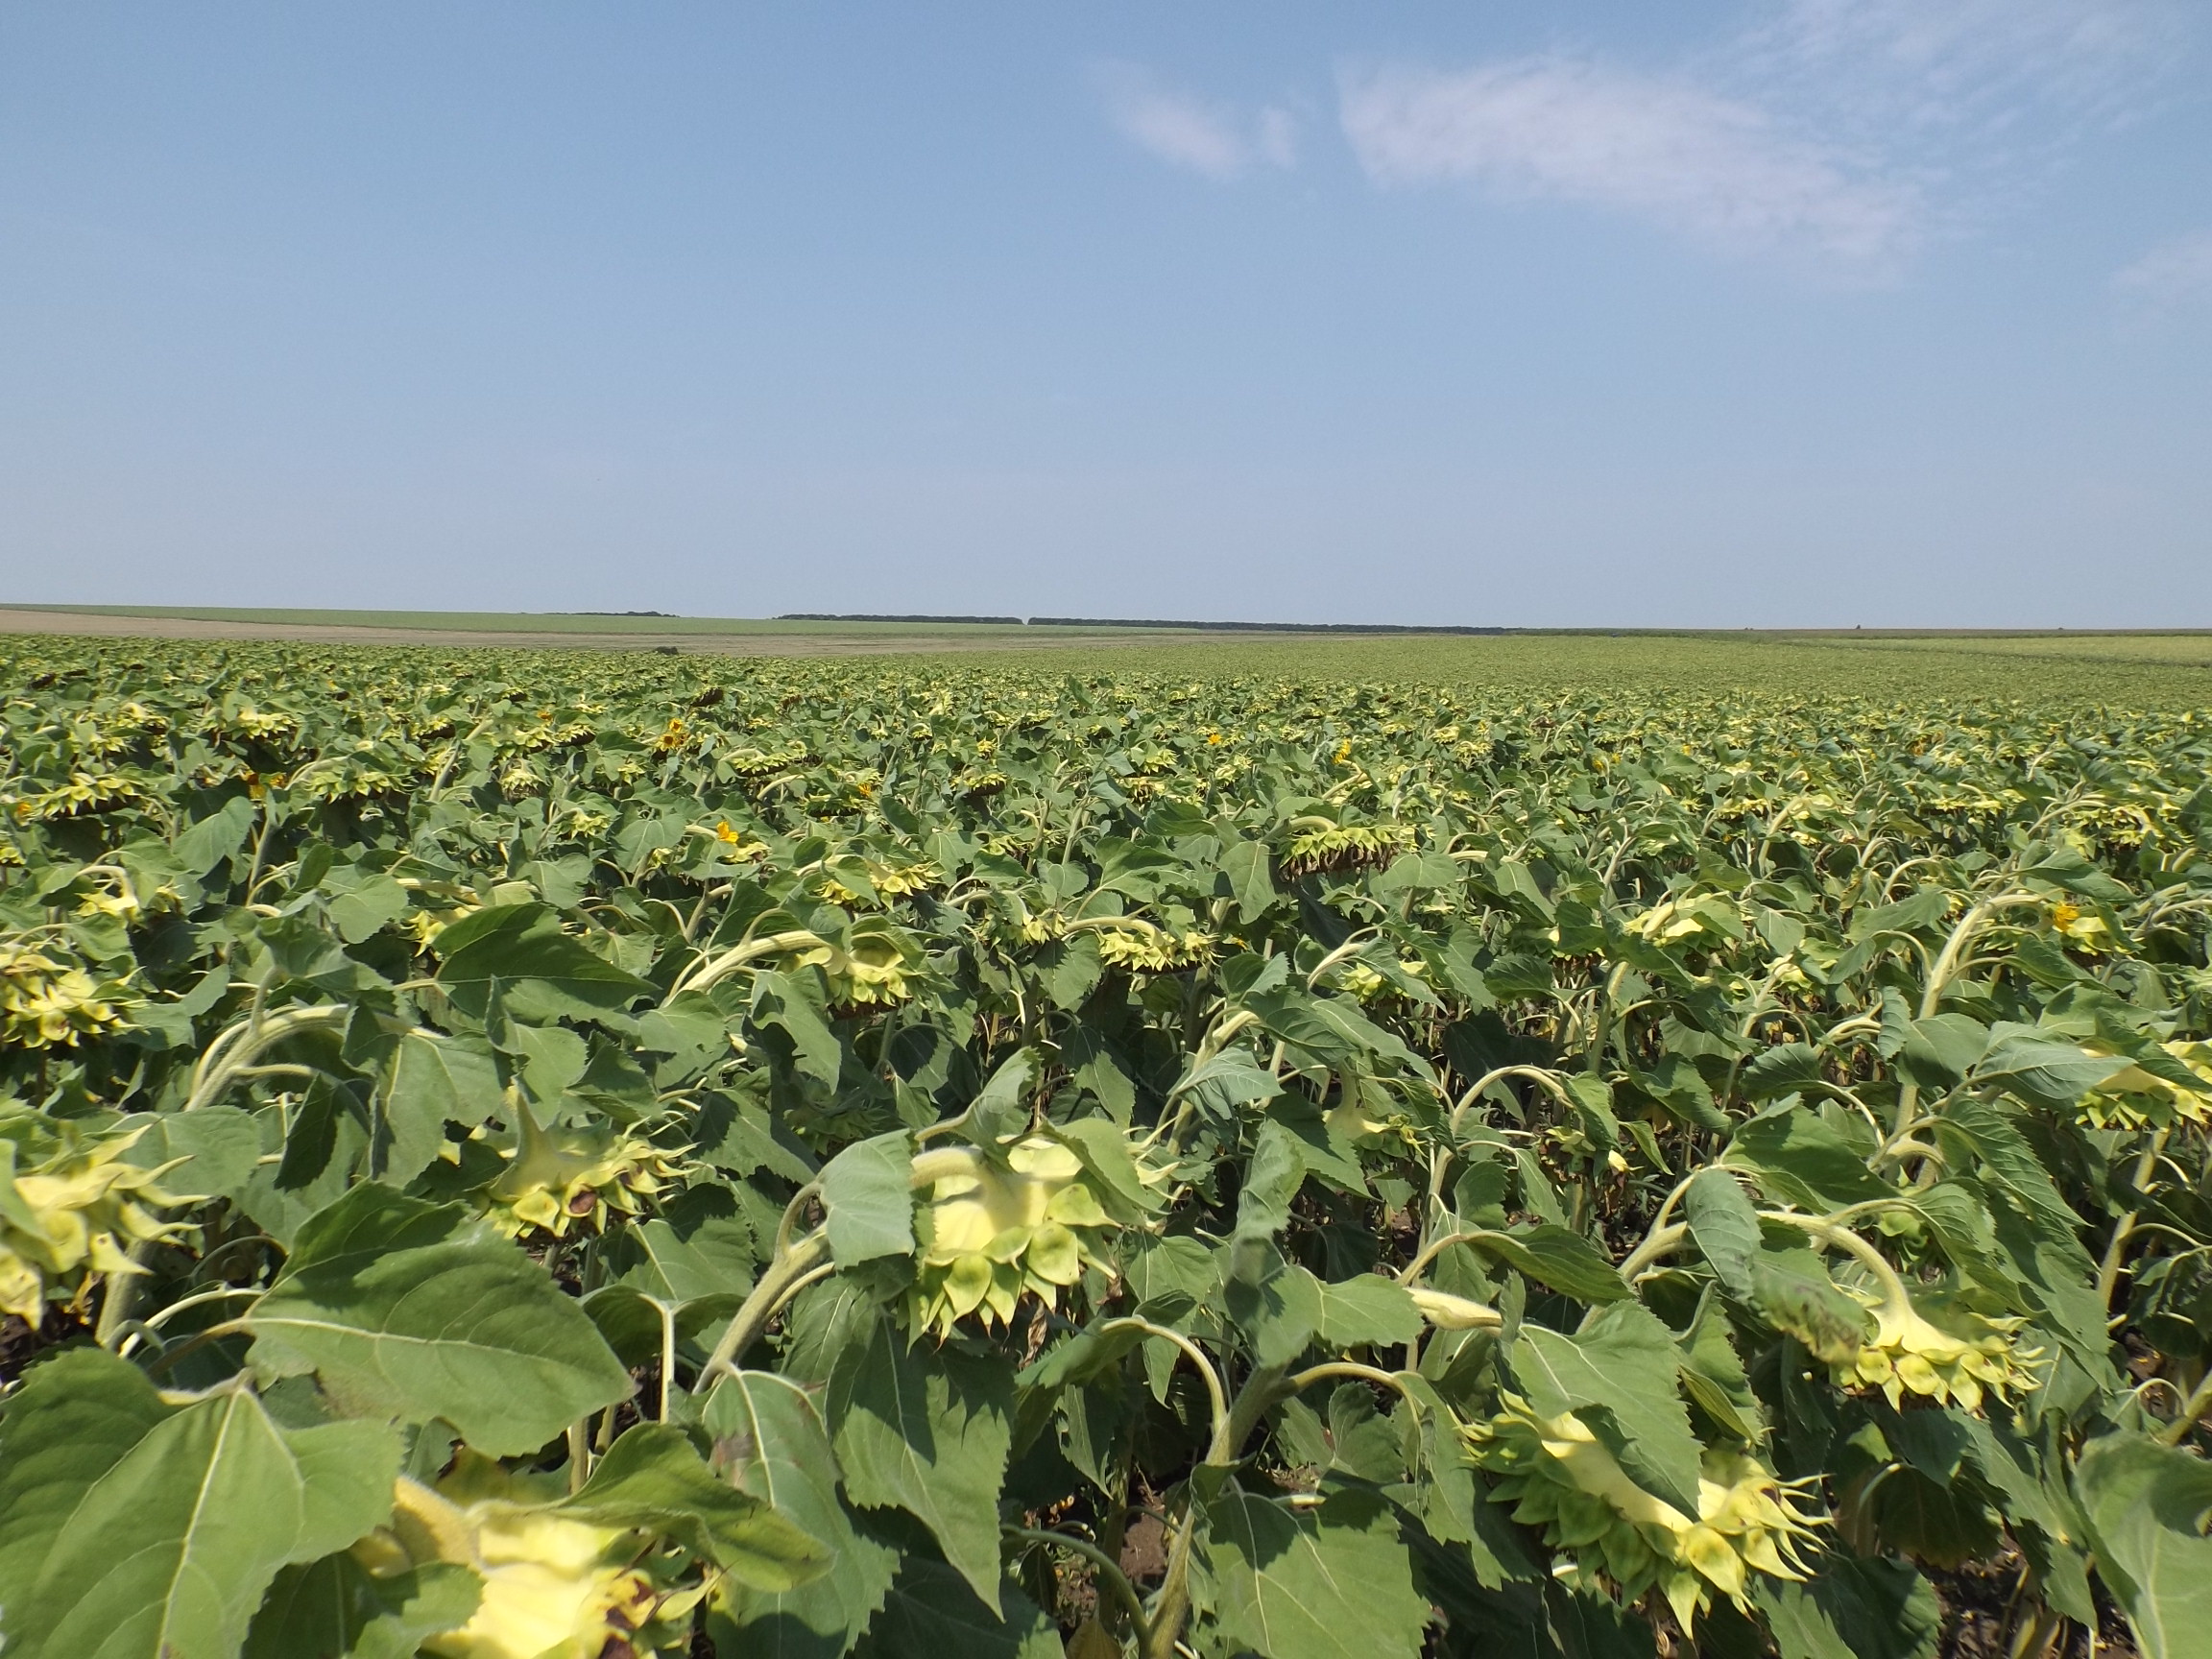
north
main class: Cropland
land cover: Sunflower
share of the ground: > 75 %
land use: Agriculture (excluding fallow land and kitchen gardens)
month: July
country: BG
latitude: 43.4931
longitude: 27.5054
